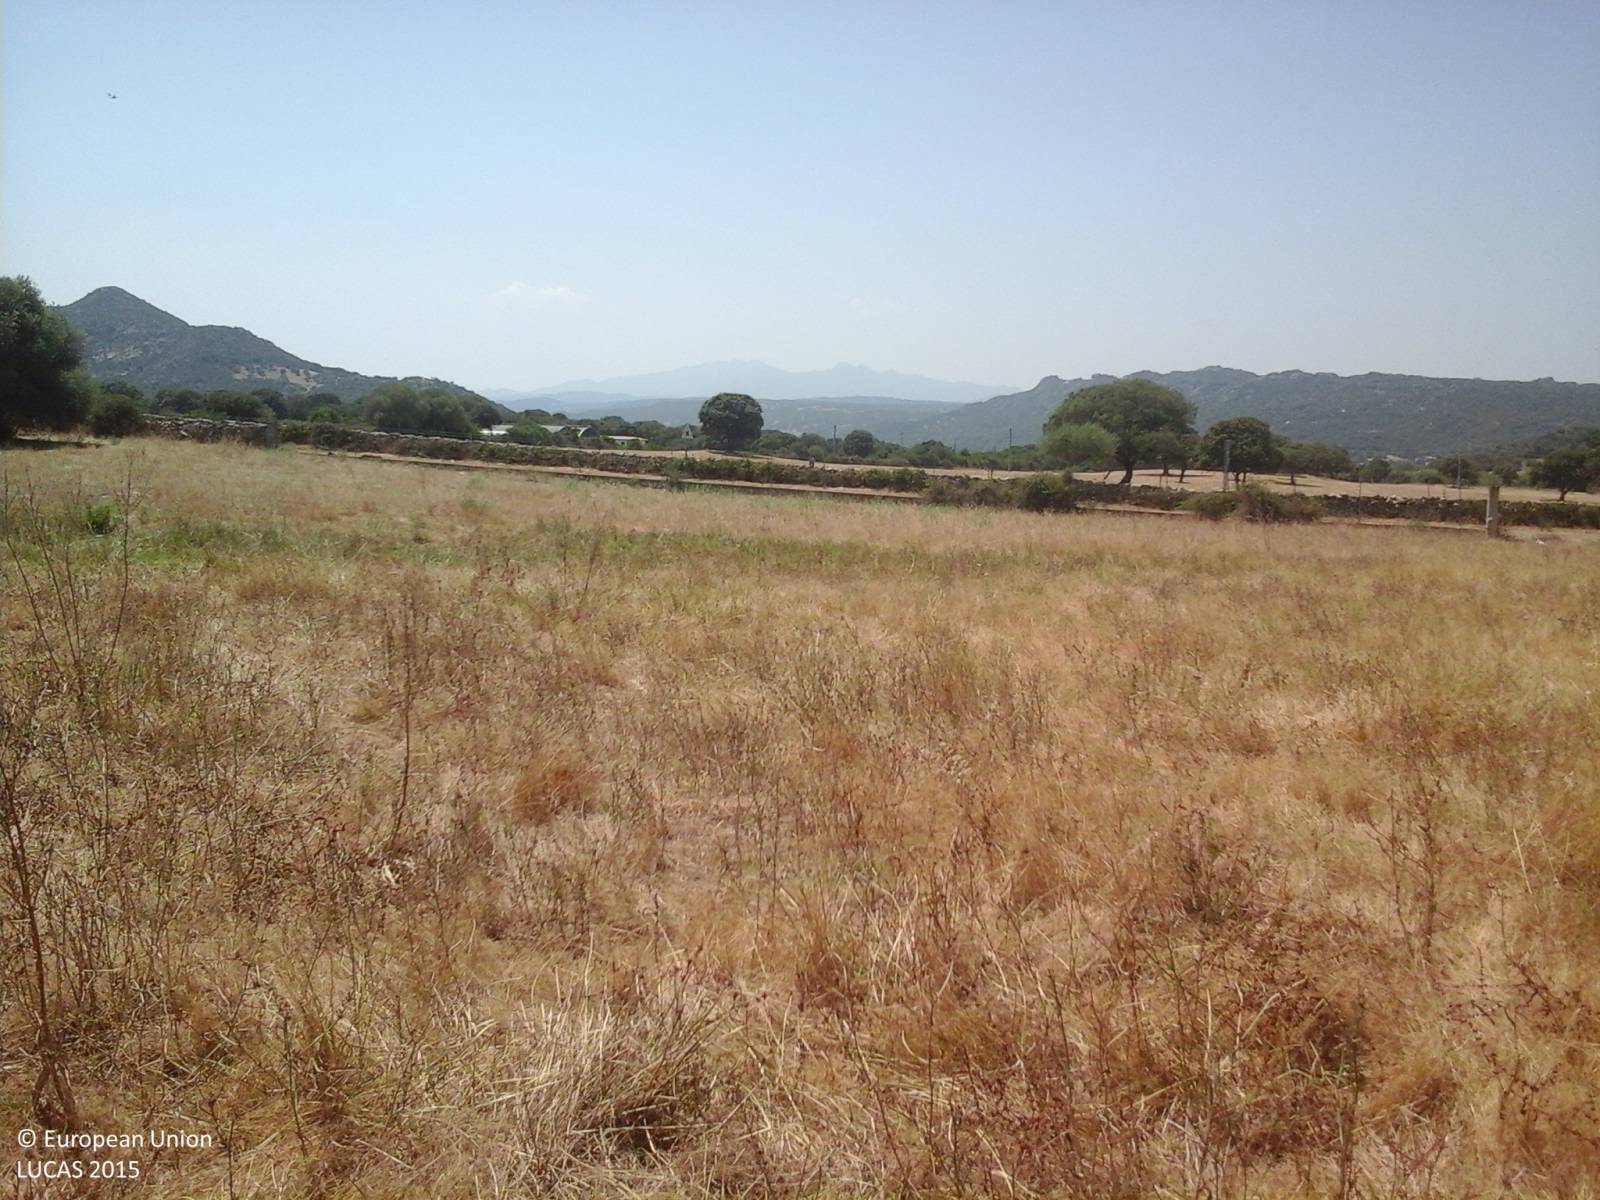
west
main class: Grassland
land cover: Grassland without tree/shrub cover
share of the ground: > 75 %
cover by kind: herbaceous plants 95 %, shrubs 5 %
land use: Agriculture (excluding fallow land and kitchen gardens)
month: July
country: IT
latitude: 40.8449
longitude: 9.4452
